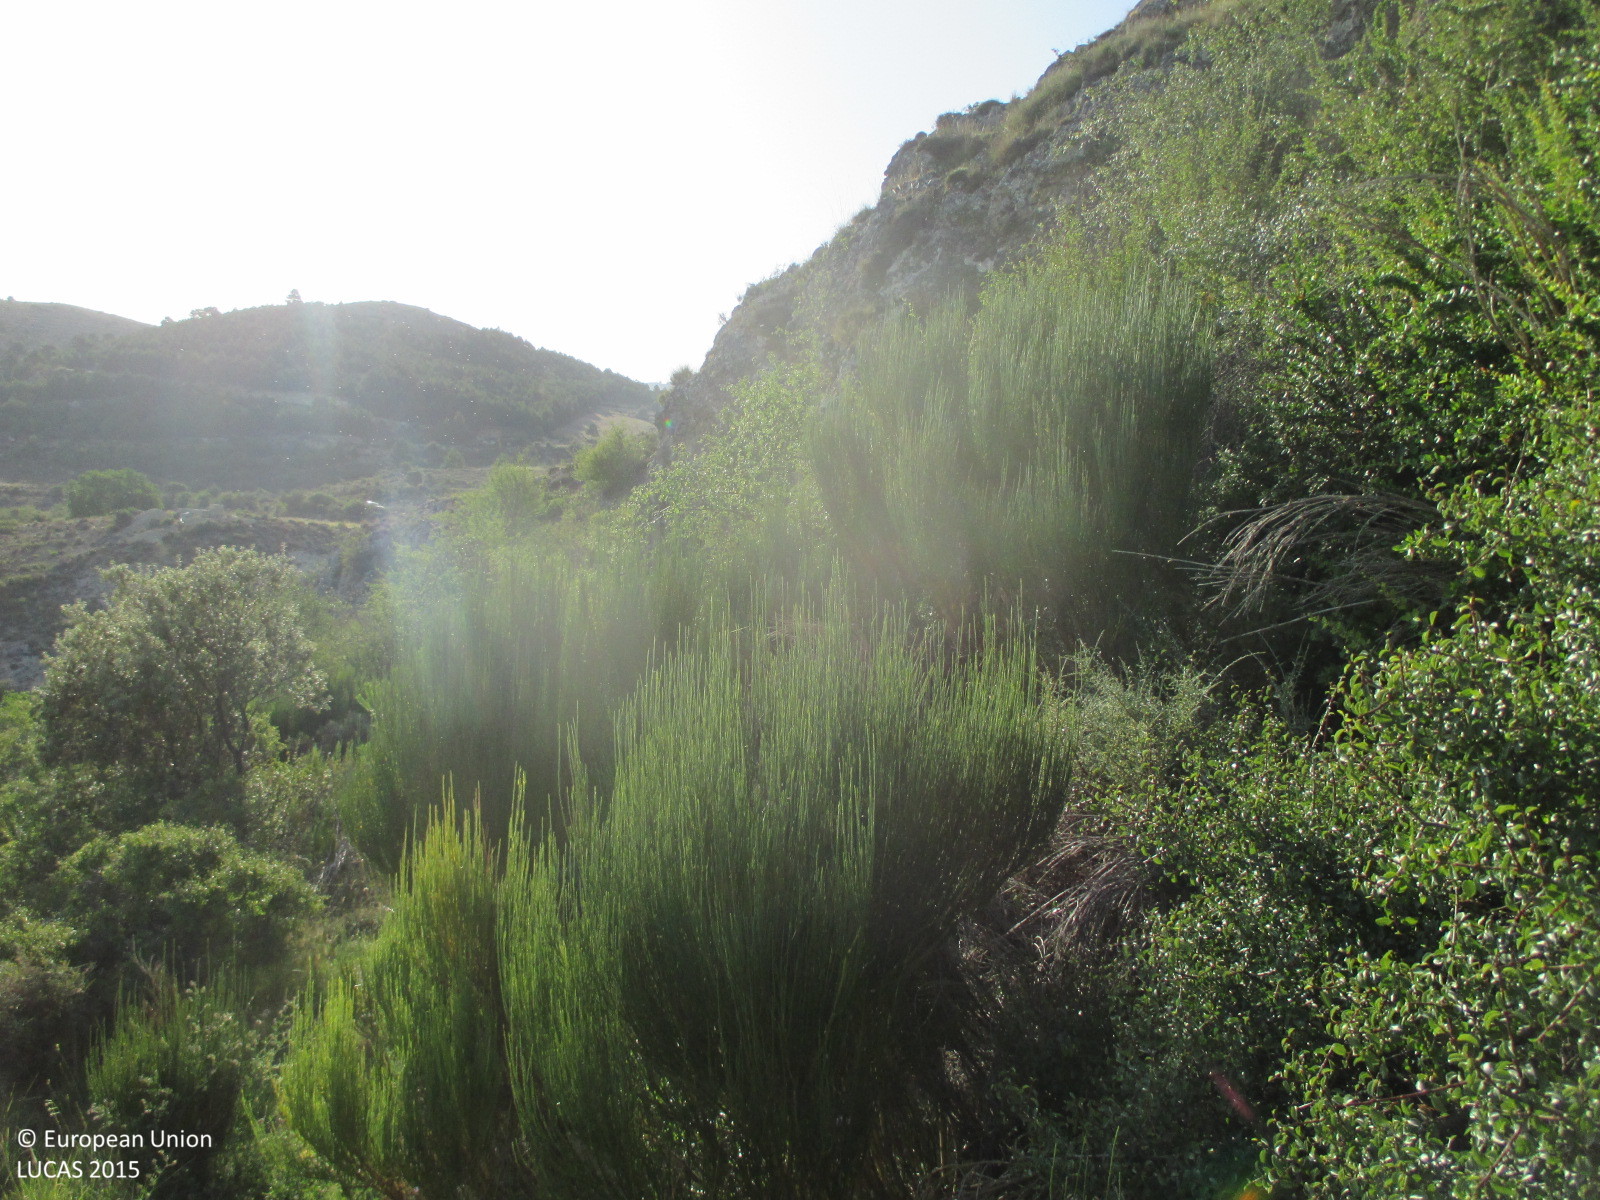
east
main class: Shrubland
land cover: Shrubland without tree cover
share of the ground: > 75 %
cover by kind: shrubs 90 %, herbaceous plants 10 %
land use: Semi-natural and natural areas not in use
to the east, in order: Shrubland without tree cover; Grassland without tree/shrub cover; Fences; Broadleaved woodland; Fences; Grassland without tree/shrub cover; Shruby margins; Tracks; Grassland with sparse tree/shrub cover
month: July
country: ES
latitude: 38.0856
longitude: -2.4087
